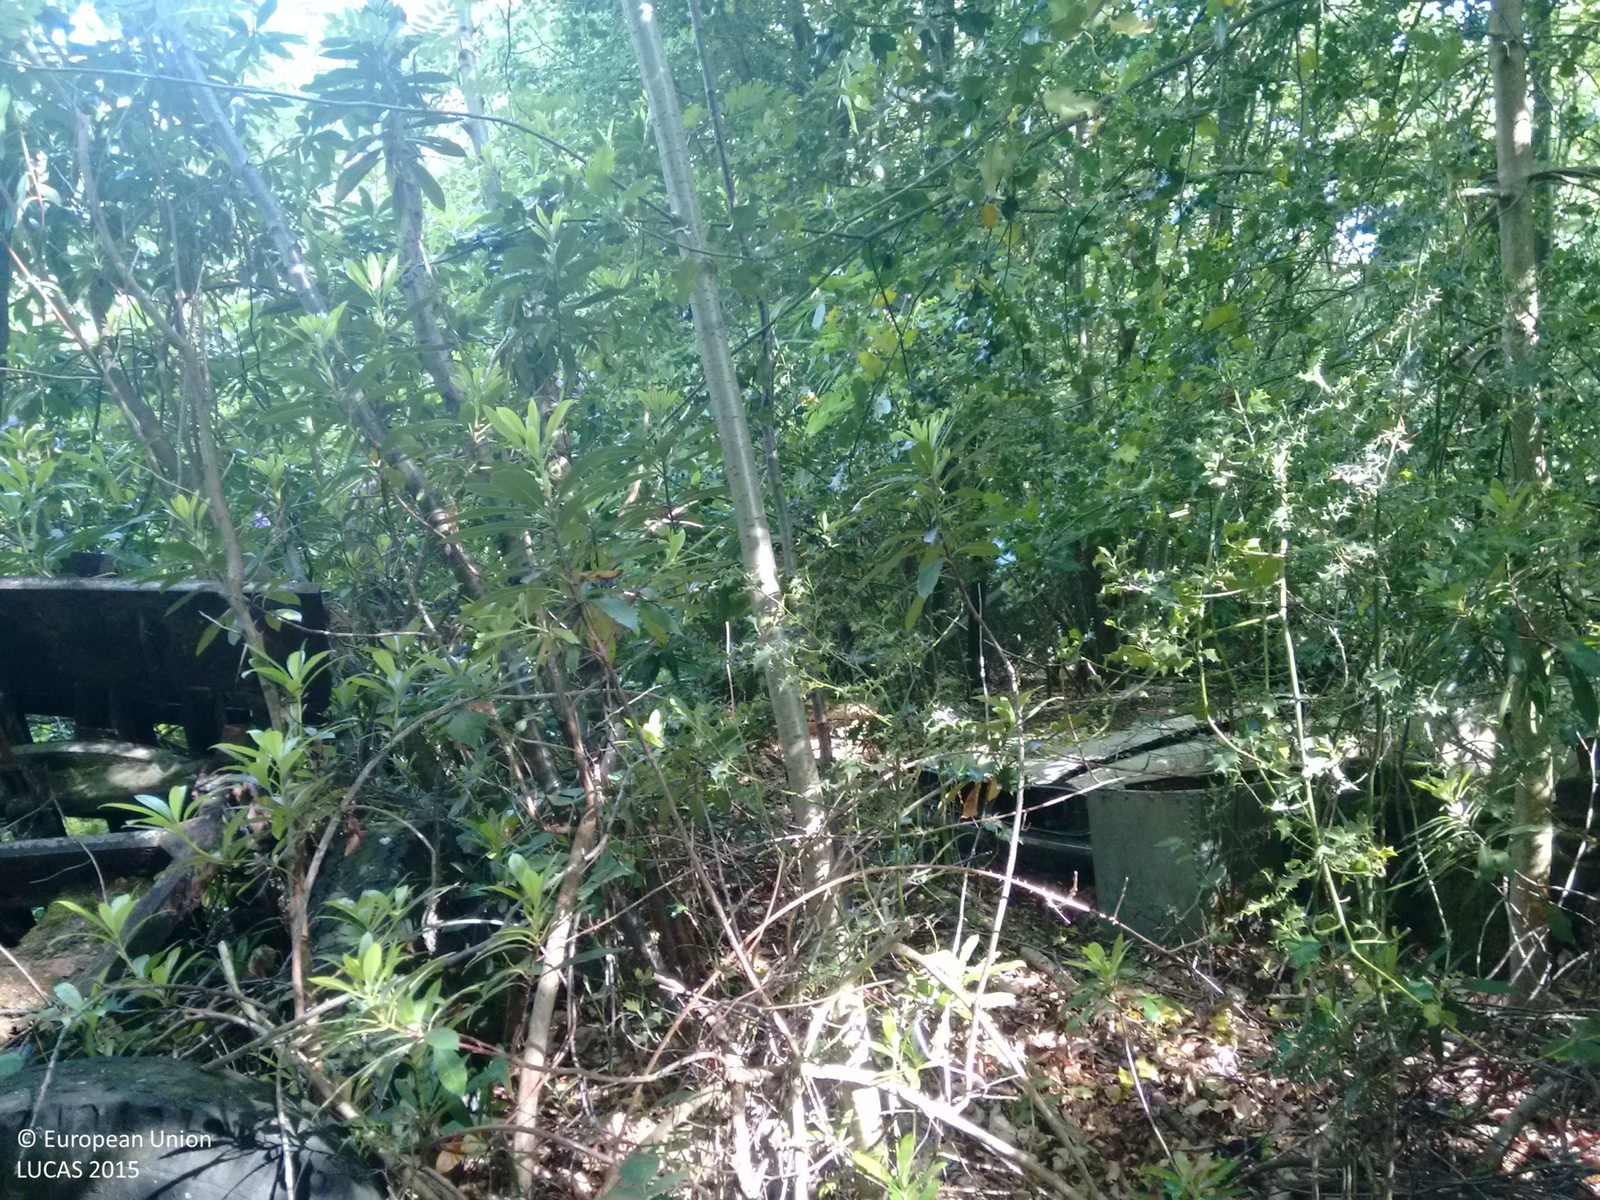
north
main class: Woodland
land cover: Other mixed woodland
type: mesophytic deciduous forest
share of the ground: > 75 %
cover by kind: broadleaved forest trees 75 %, coniferous forest trees 25 %
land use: Semi-natural and natural areas not in use
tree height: > 5 m
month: June
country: GB
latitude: 50.9759
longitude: 0.2134
